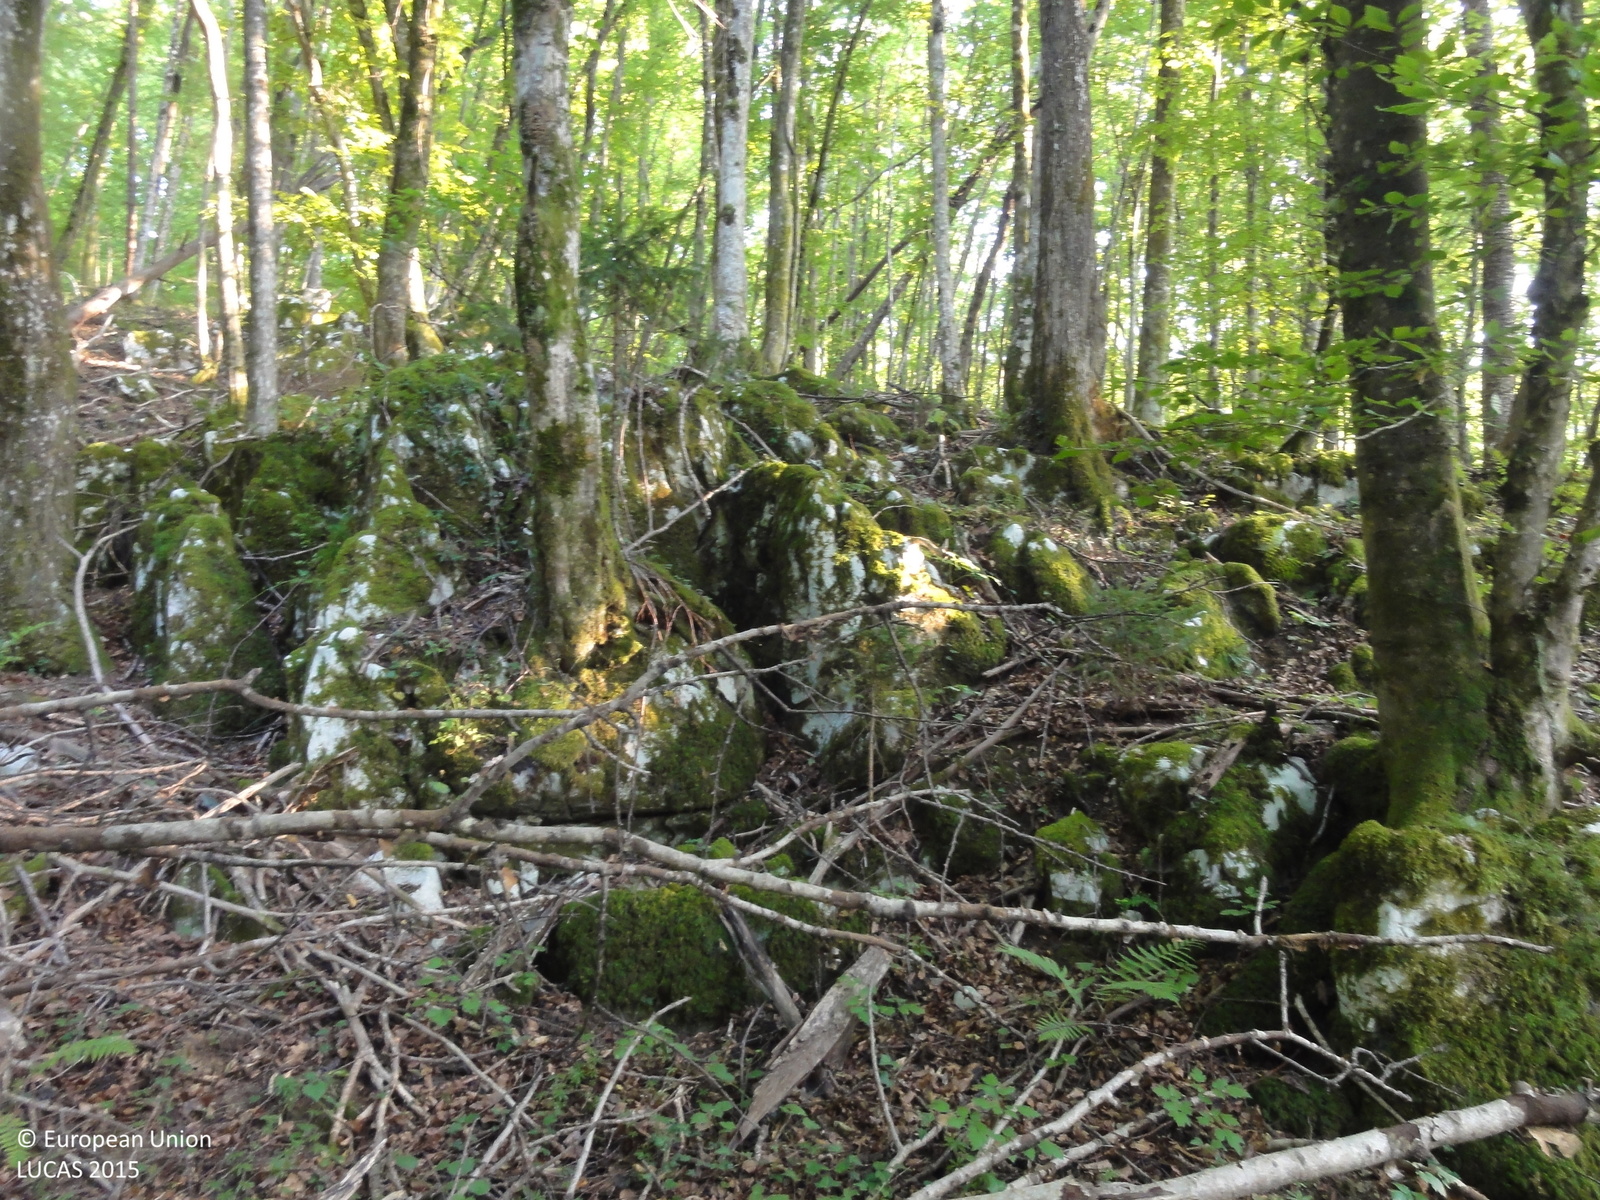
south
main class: Woodland
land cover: Broadleaved woodland
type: beech forest
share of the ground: > 75 %
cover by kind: broadleaved forest trees 95 %, coniferous forest trees 5 %
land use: Forestry
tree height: > 5 m
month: August
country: SI
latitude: 45.8370
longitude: 15.0047
